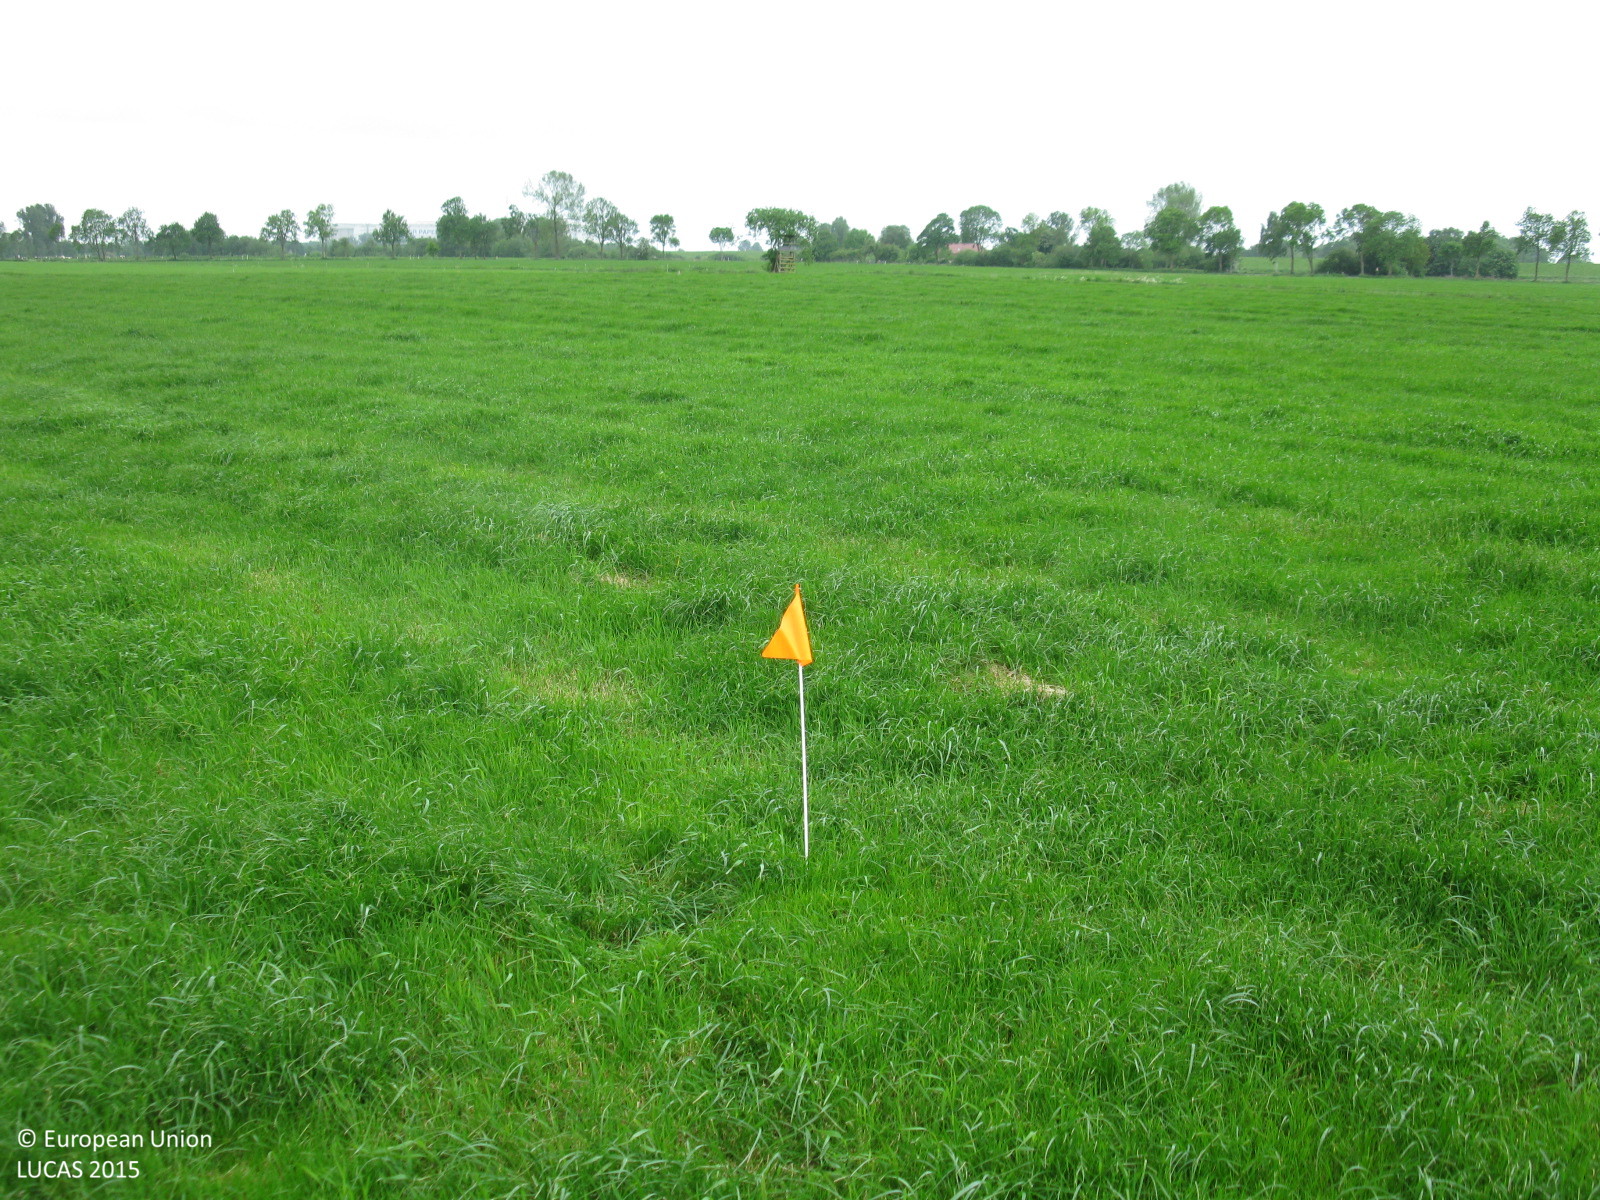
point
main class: Grassland
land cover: Grassland without tree/shrub cover
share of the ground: > 75 %
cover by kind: herbaceous plants 100 %
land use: Agriculture (excluding fallow land and kitchen gardens)
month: June
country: DE
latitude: 53.1220
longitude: 7.3856
